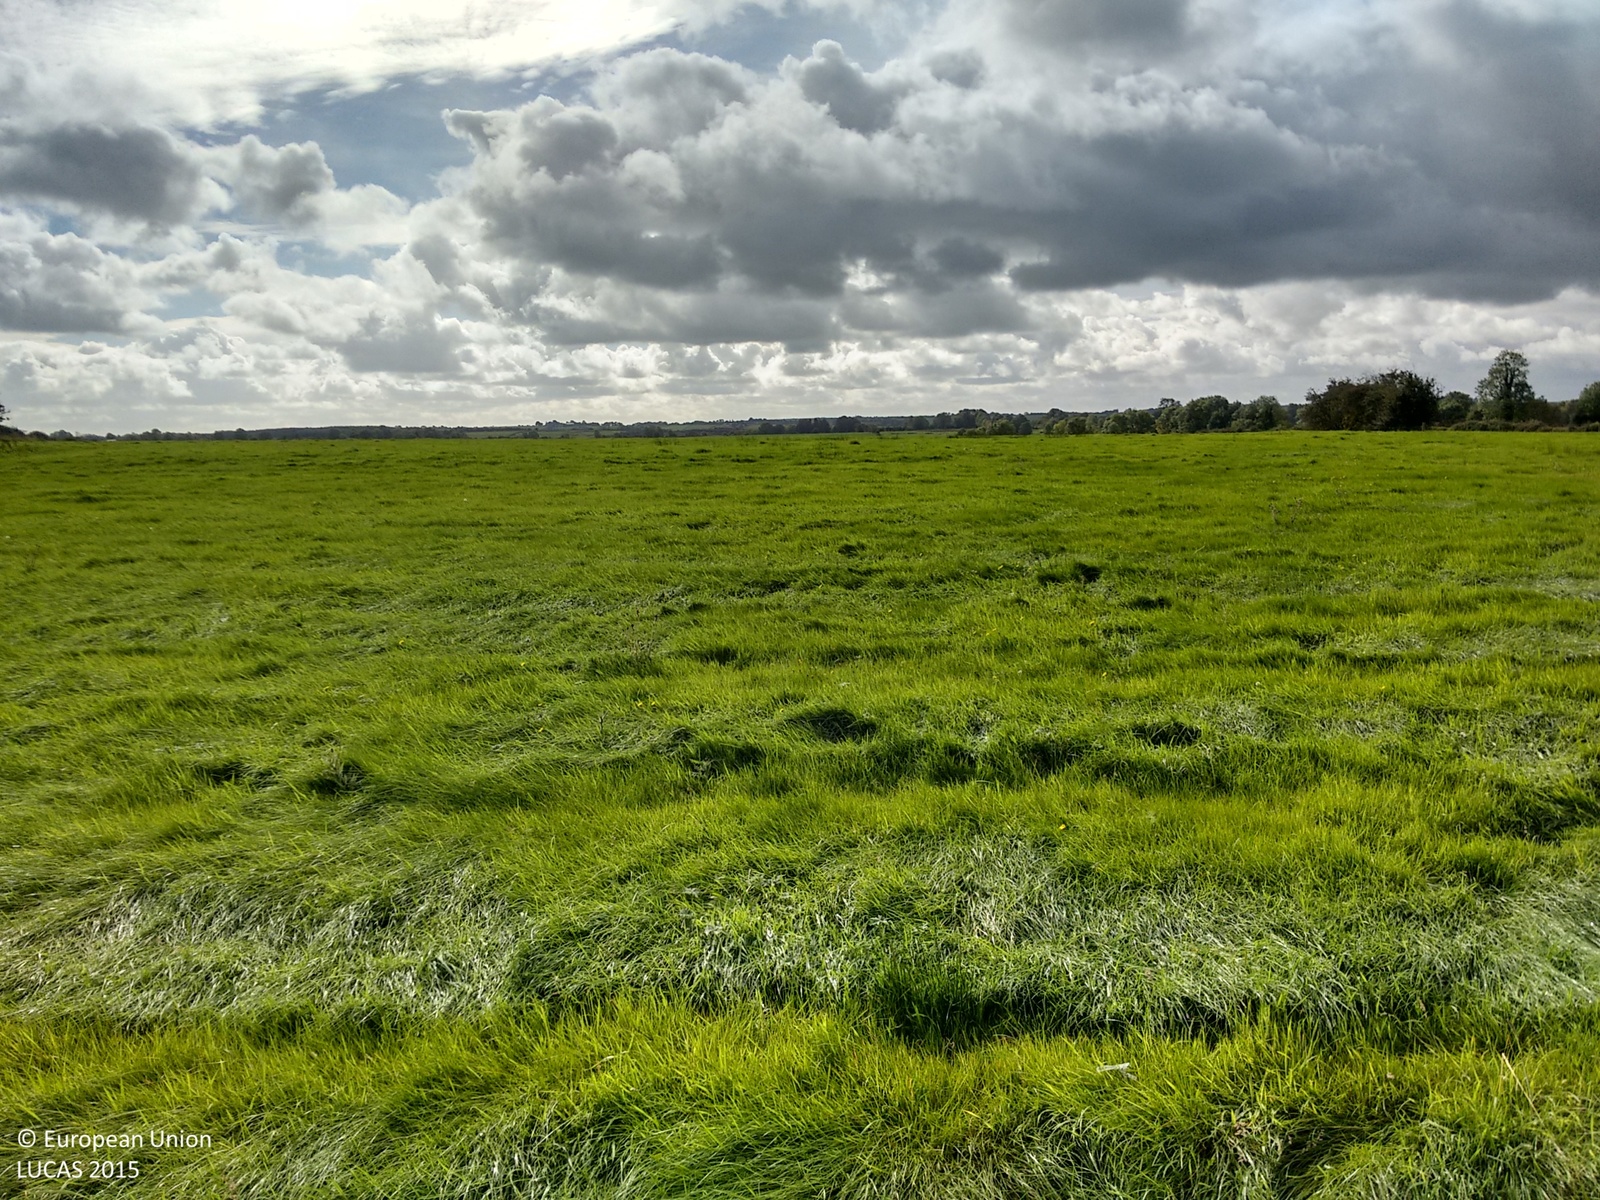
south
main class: Grassland
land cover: Grassland without tree/shrub cover
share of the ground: > 75 %
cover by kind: herbaceous plants 100 %
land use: Agriculture (excluding fallow land and kitchen gardens)
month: October
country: IE
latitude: 53.7615
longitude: -8.1870
